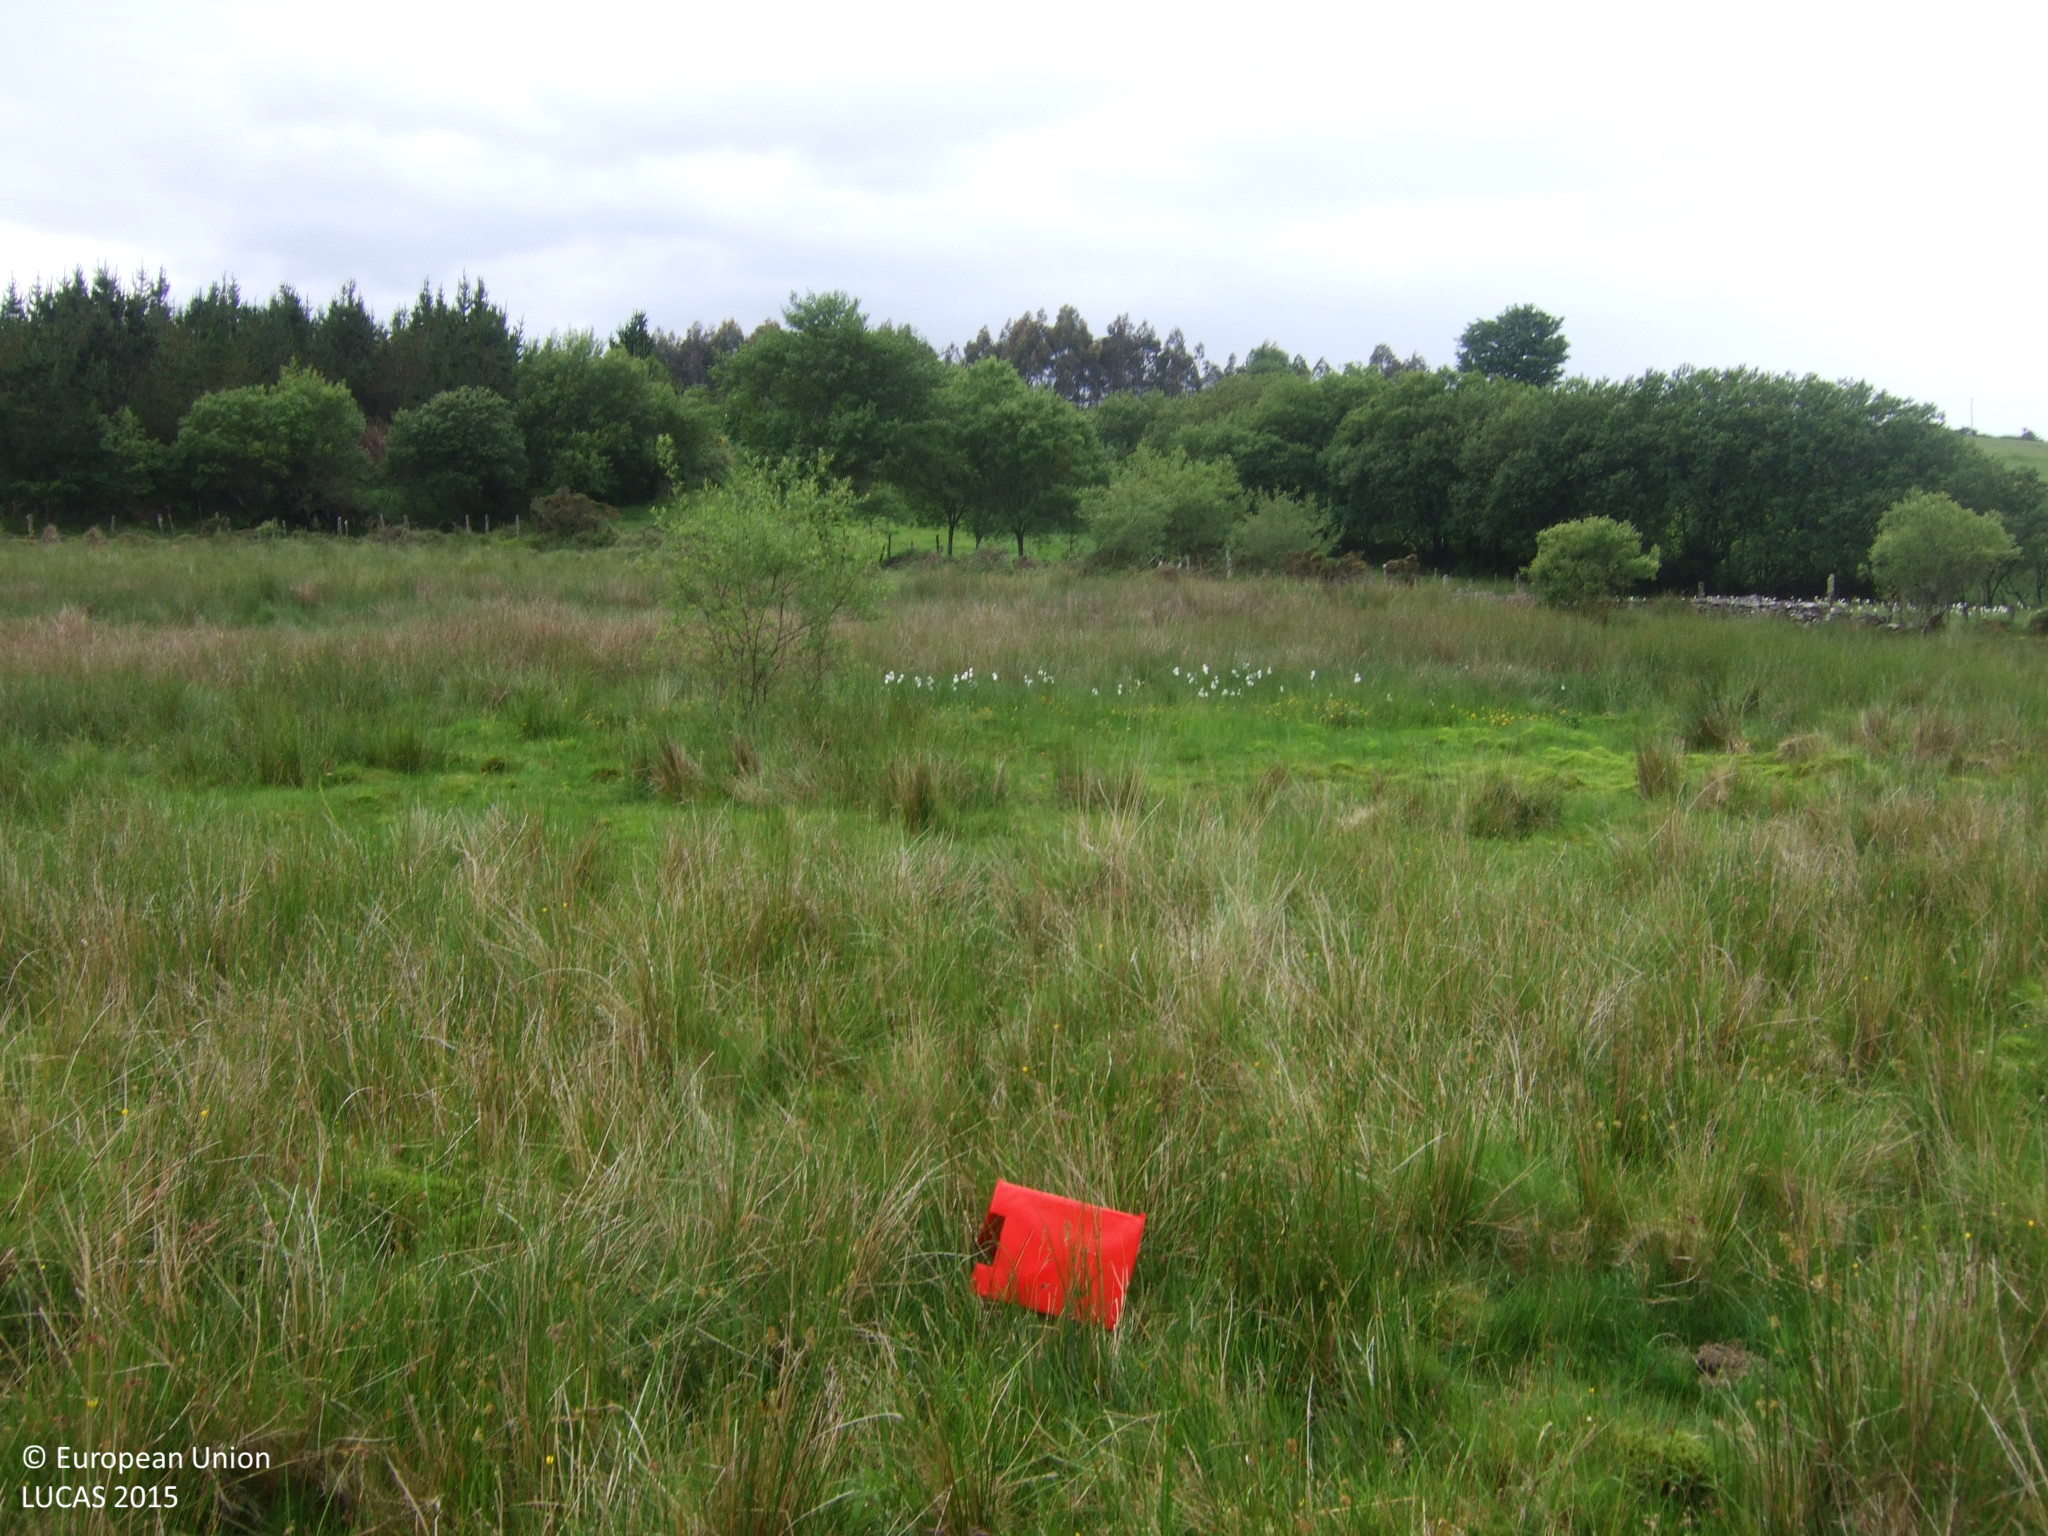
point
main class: Grassland
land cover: Grassland without tree/shrub cover
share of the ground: > 75 %
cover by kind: herbaceous plants 100 %
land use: Agriculture (excluding fallow land and kitchen gardens)
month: June
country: ES
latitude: 43.4231
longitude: -7.4839
